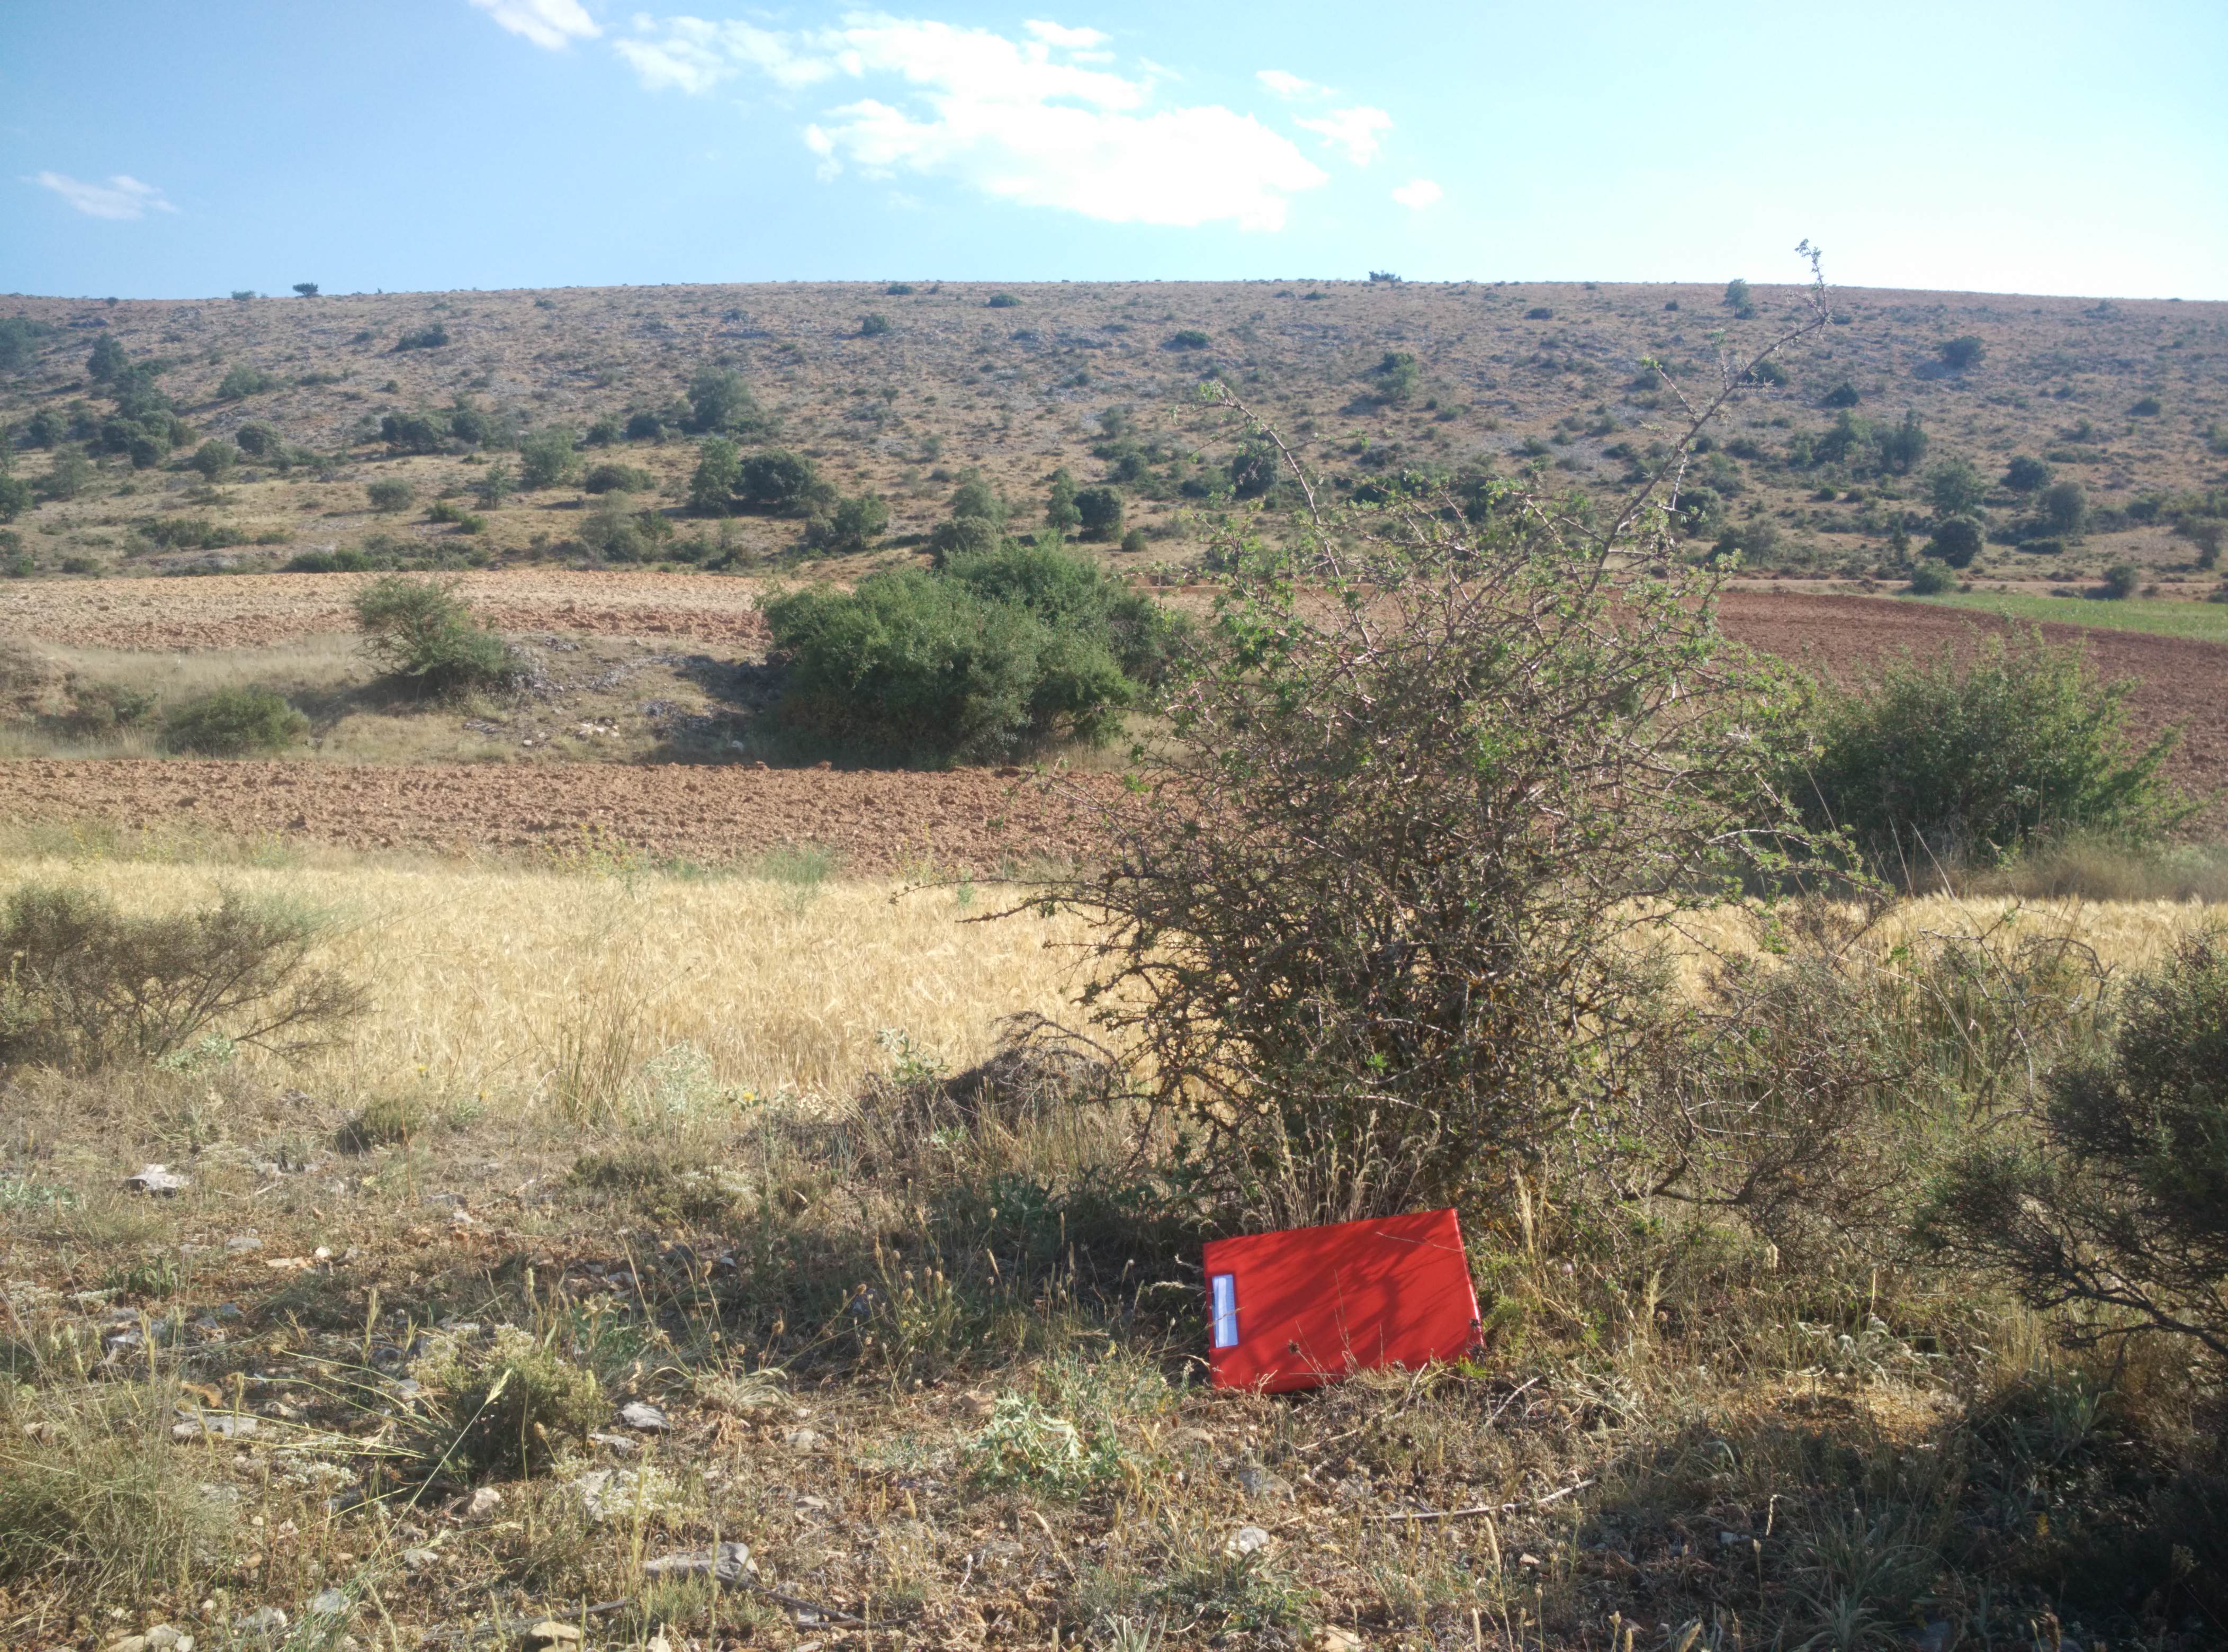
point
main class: Shrubland
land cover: Shrubland without tree cover
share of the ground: 10 - 25 %
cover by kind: unconsolidated bare surface 45 %, shrubs 20 %, herbaceous plants 10 %
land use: Semi-natural and natural areas not in use
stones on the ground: 10 - 25 %
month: July
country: ES
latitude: 41.0081
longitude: -2.1423
